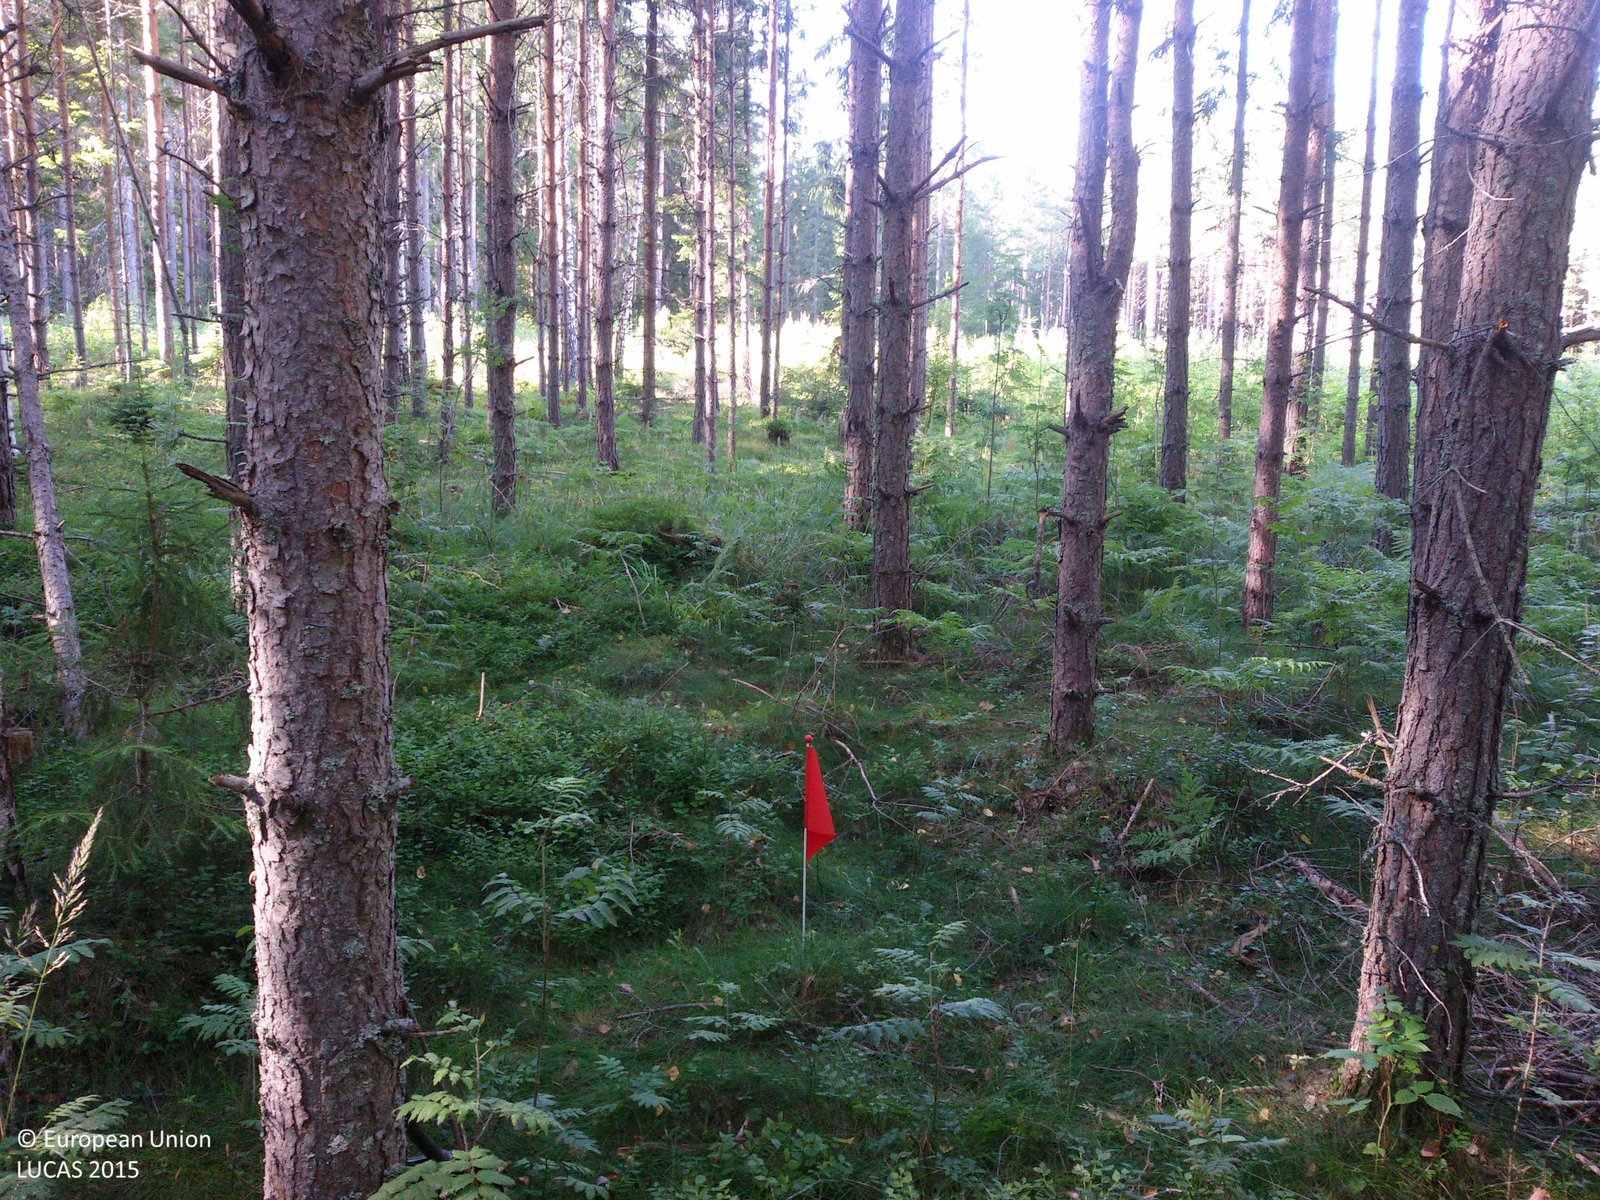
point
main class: Woodland
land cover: Pine dominated mixed woodland
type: boreal forest
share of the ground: > 75 %
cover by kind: coniferous forest trees 50 %, broadleaved forest trees 45 %, shrubs 5 %
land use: Forestry
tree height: > 5 m
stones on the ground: < 10 %
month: August
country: SE
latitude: 60.5762
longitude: 16.4298
